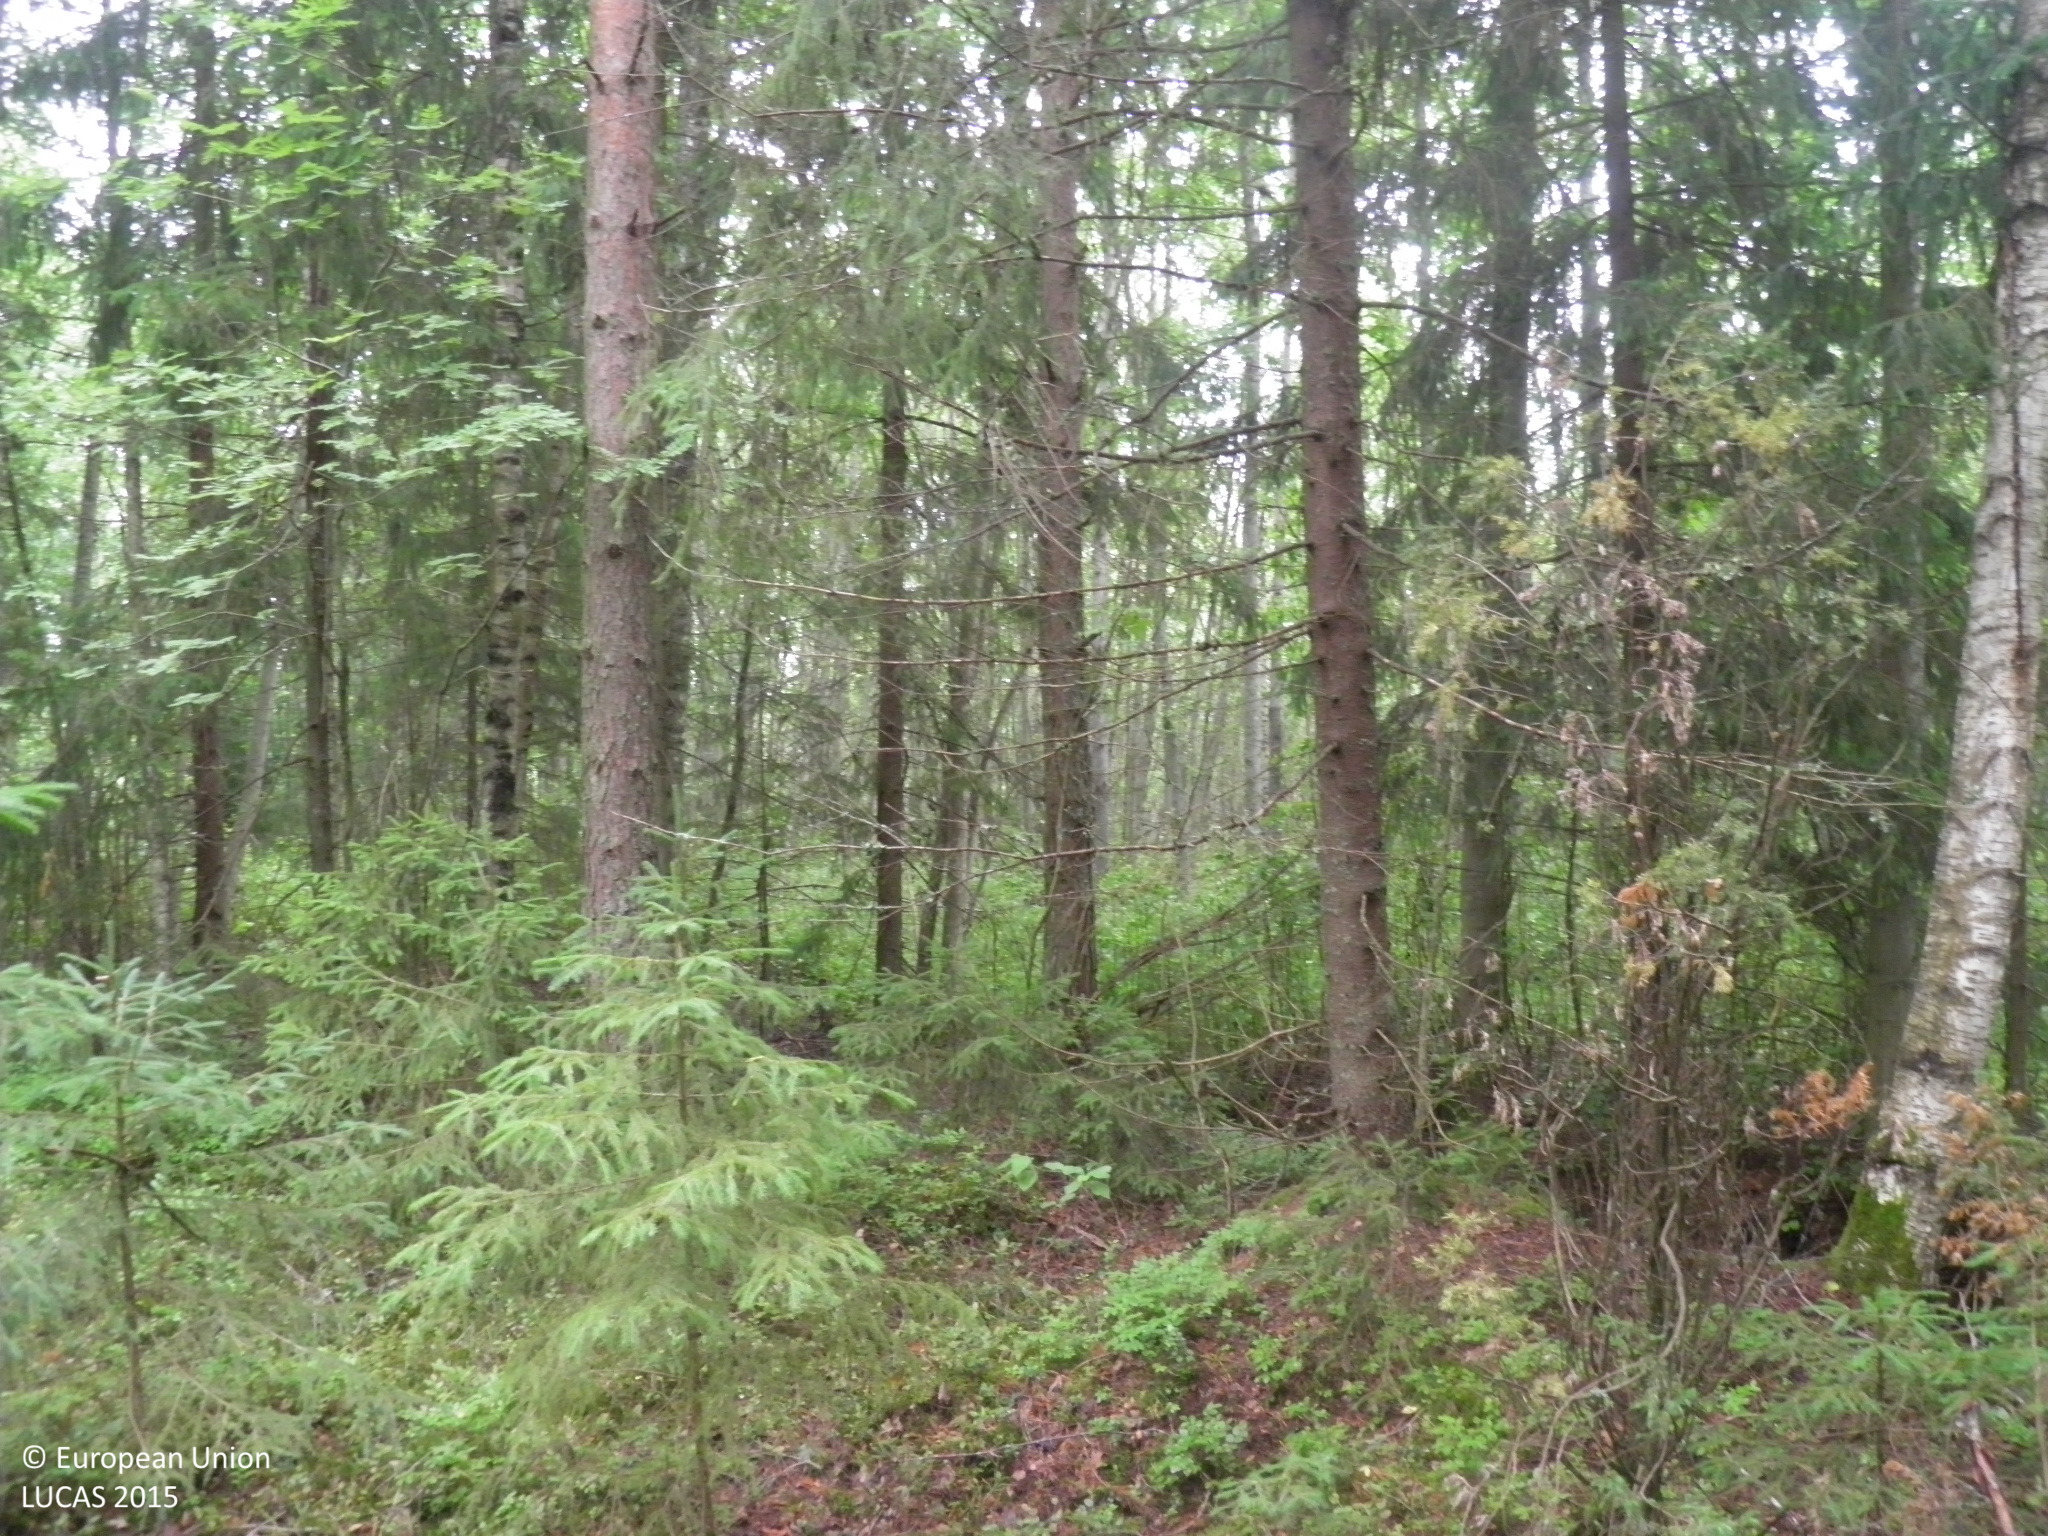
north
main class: Woodland
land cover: Pine dominated mixed woodland
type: hemiboreal forest and nemoral coniferous forest and mixed broadleaved-coniferous forest
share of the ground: 50 - 75 %
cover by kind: broadleaved forest trees 40 %, coniferous forest trees 30 %, shrubs 15 %, herbaceous plants 10 %, lichens and mosses 5 %
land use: Forestry
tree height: > 5 m
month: July
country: FI
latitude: 60.7439
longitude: 22.8223
